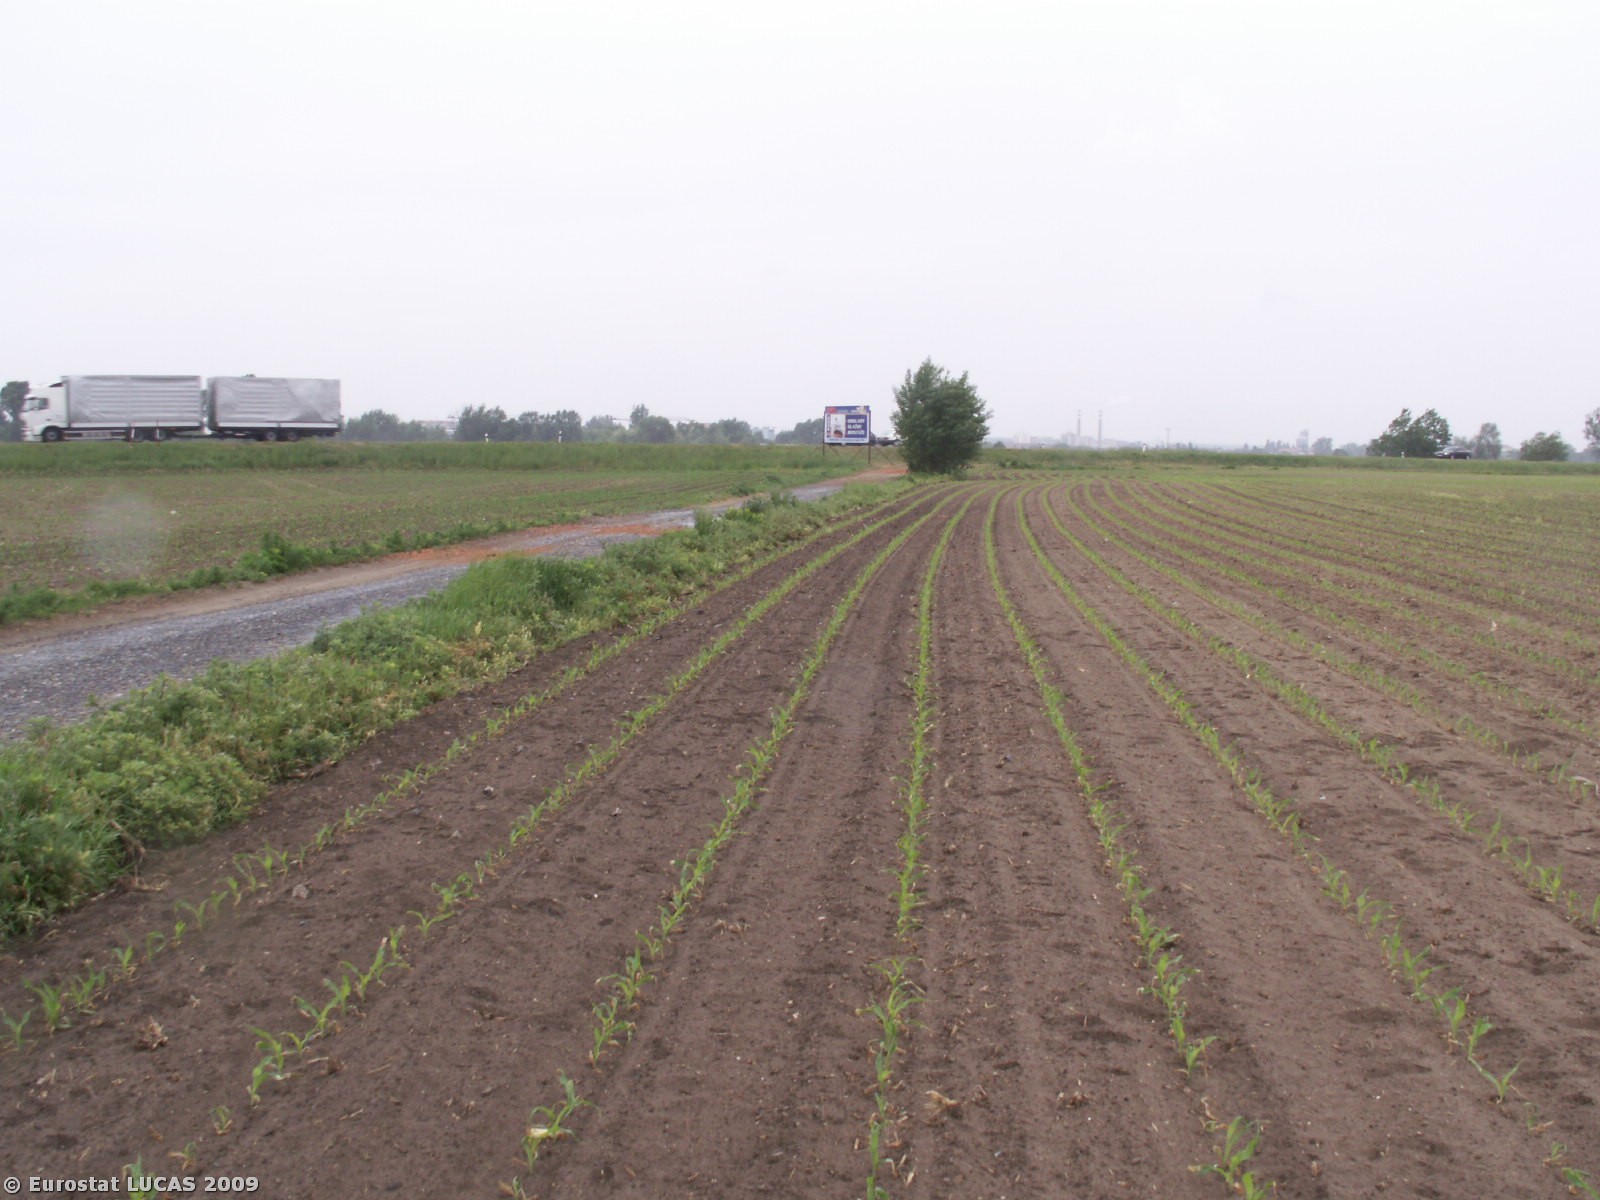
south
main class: Cropland
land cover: Maize
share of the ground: 10 - 25 %
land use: Agriculture (excluding fallow land and kitchen gardens)
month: May
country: CZ
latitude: 48.8769
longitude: 17.1406
